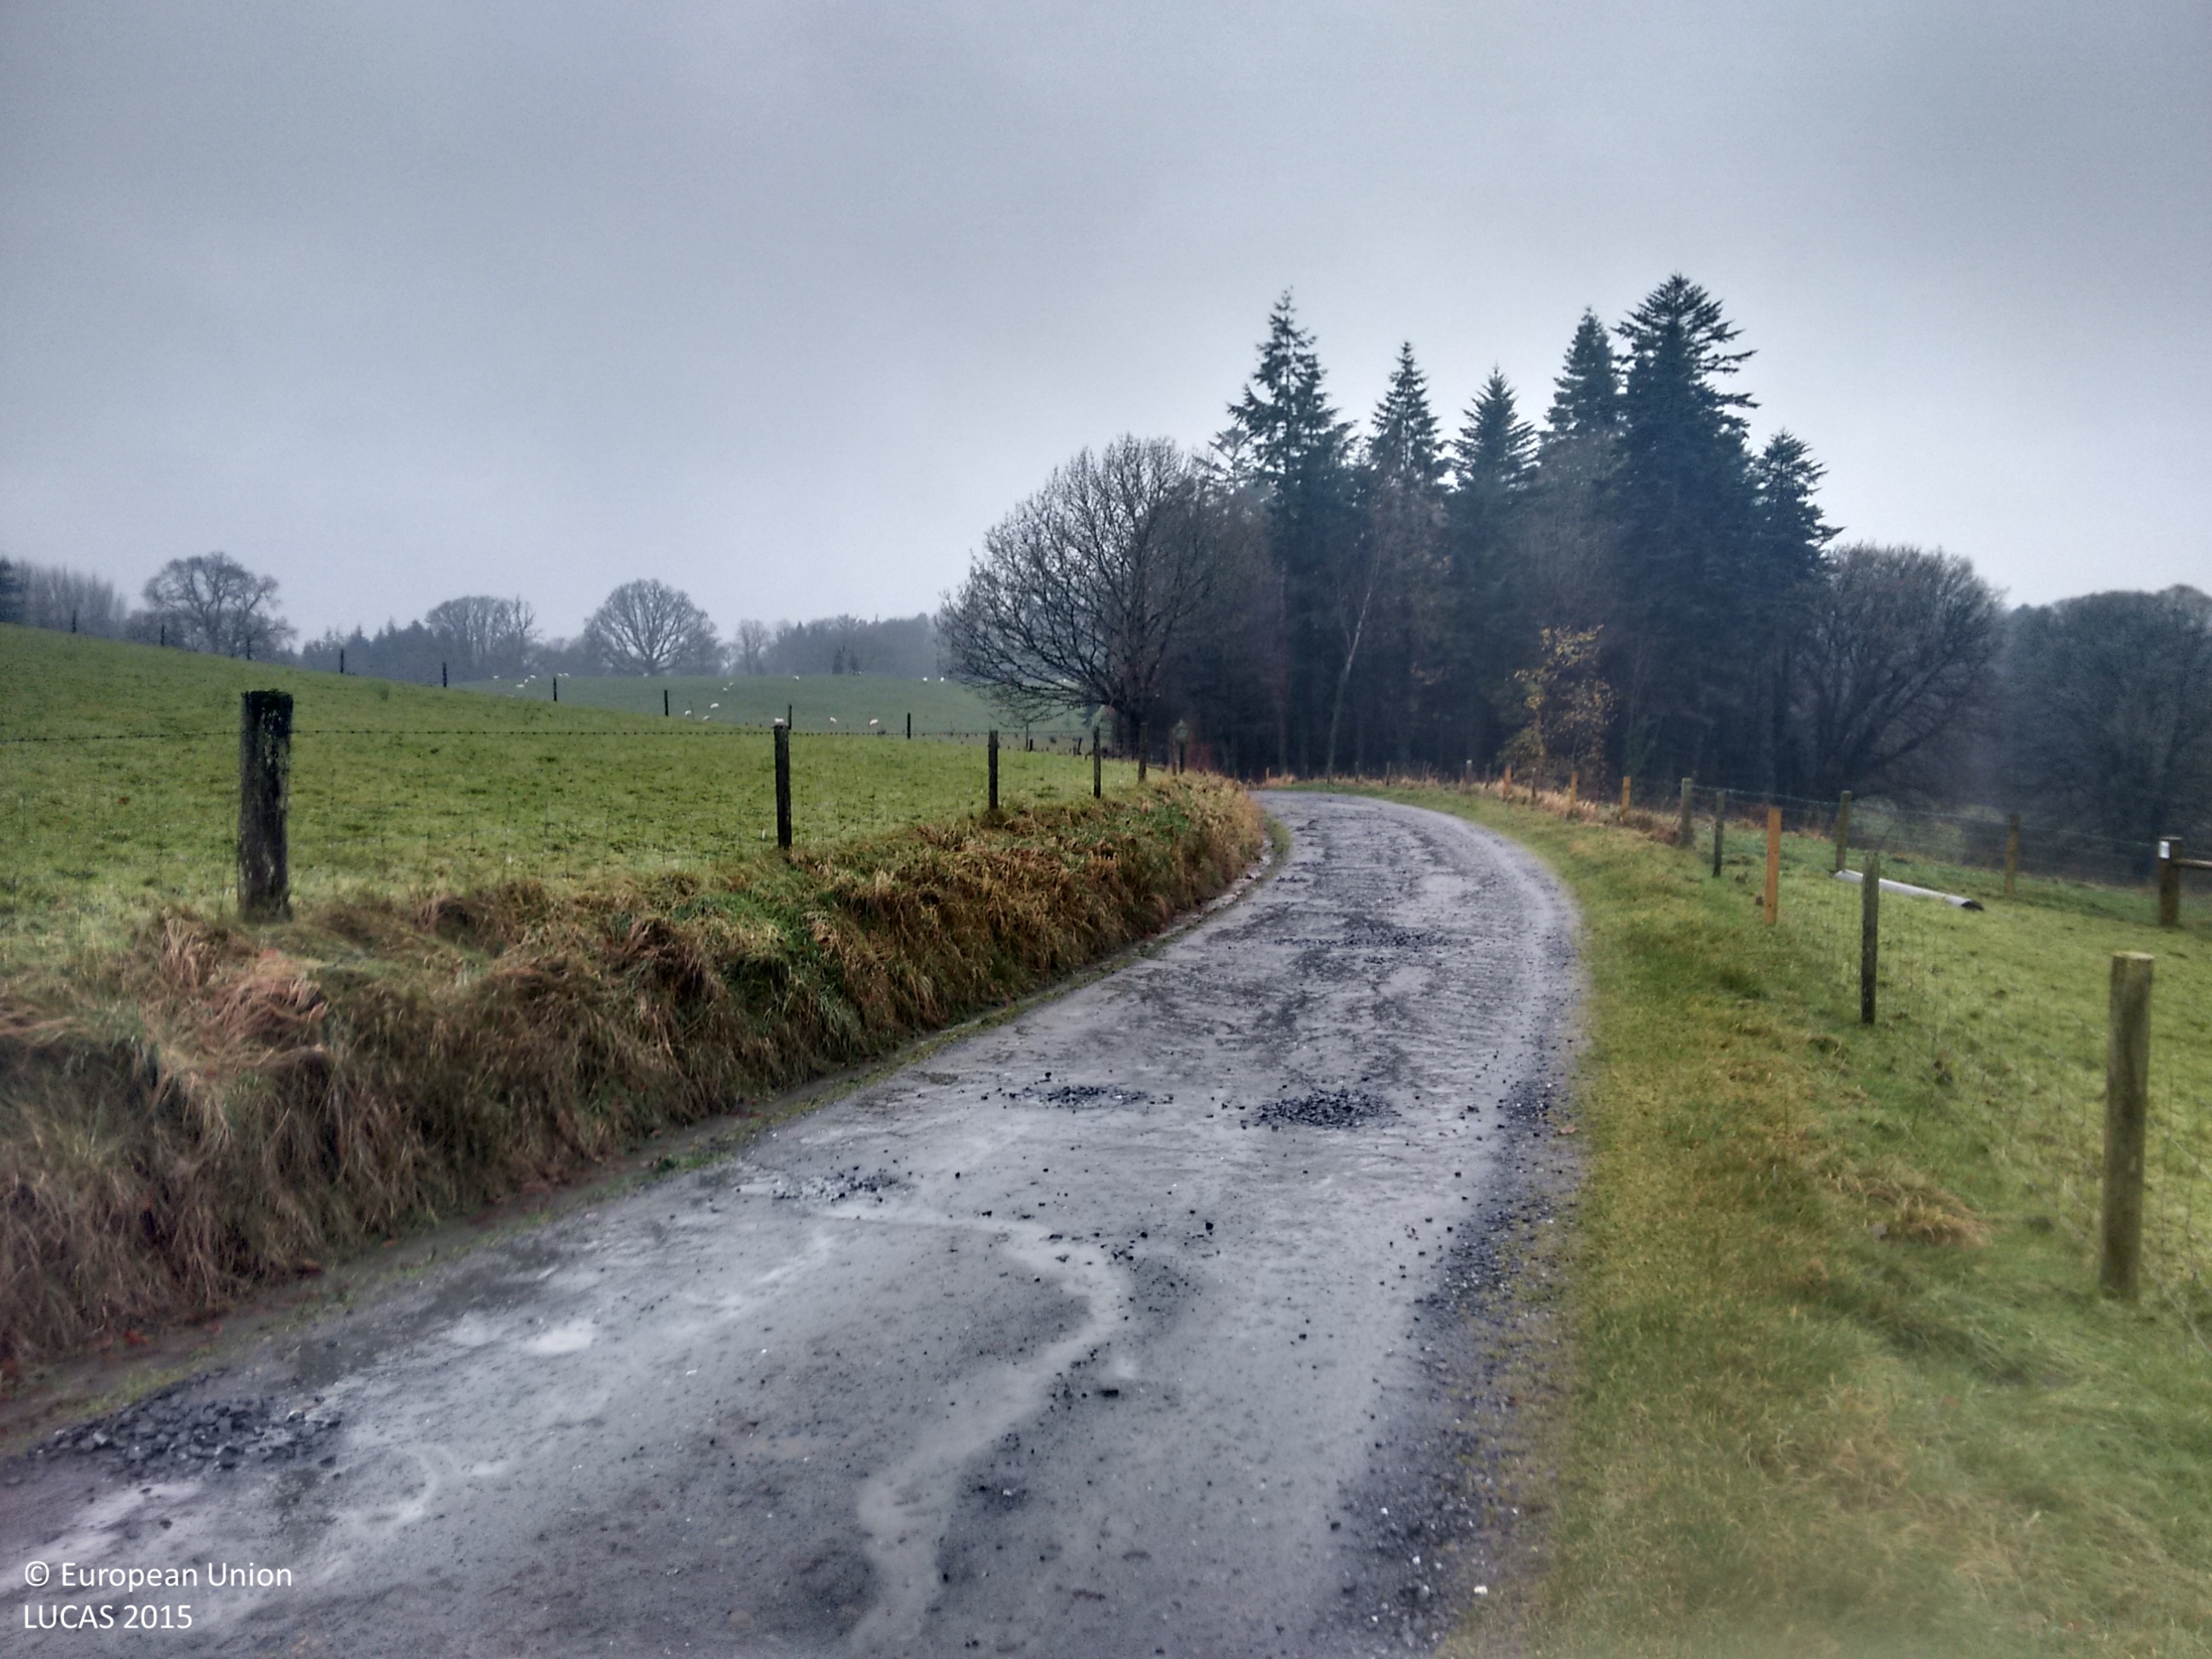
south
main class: Woodland
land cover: Other mixed woodland
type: boreal forest
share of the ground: > 75 %
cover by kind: broadleaved forest trees 60 %, coniferous forest trees 40 %
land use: Semi-natural and natural areas not in use
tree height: > 5 m
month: December
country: IE
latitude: 54.1398
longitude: -7.2463
